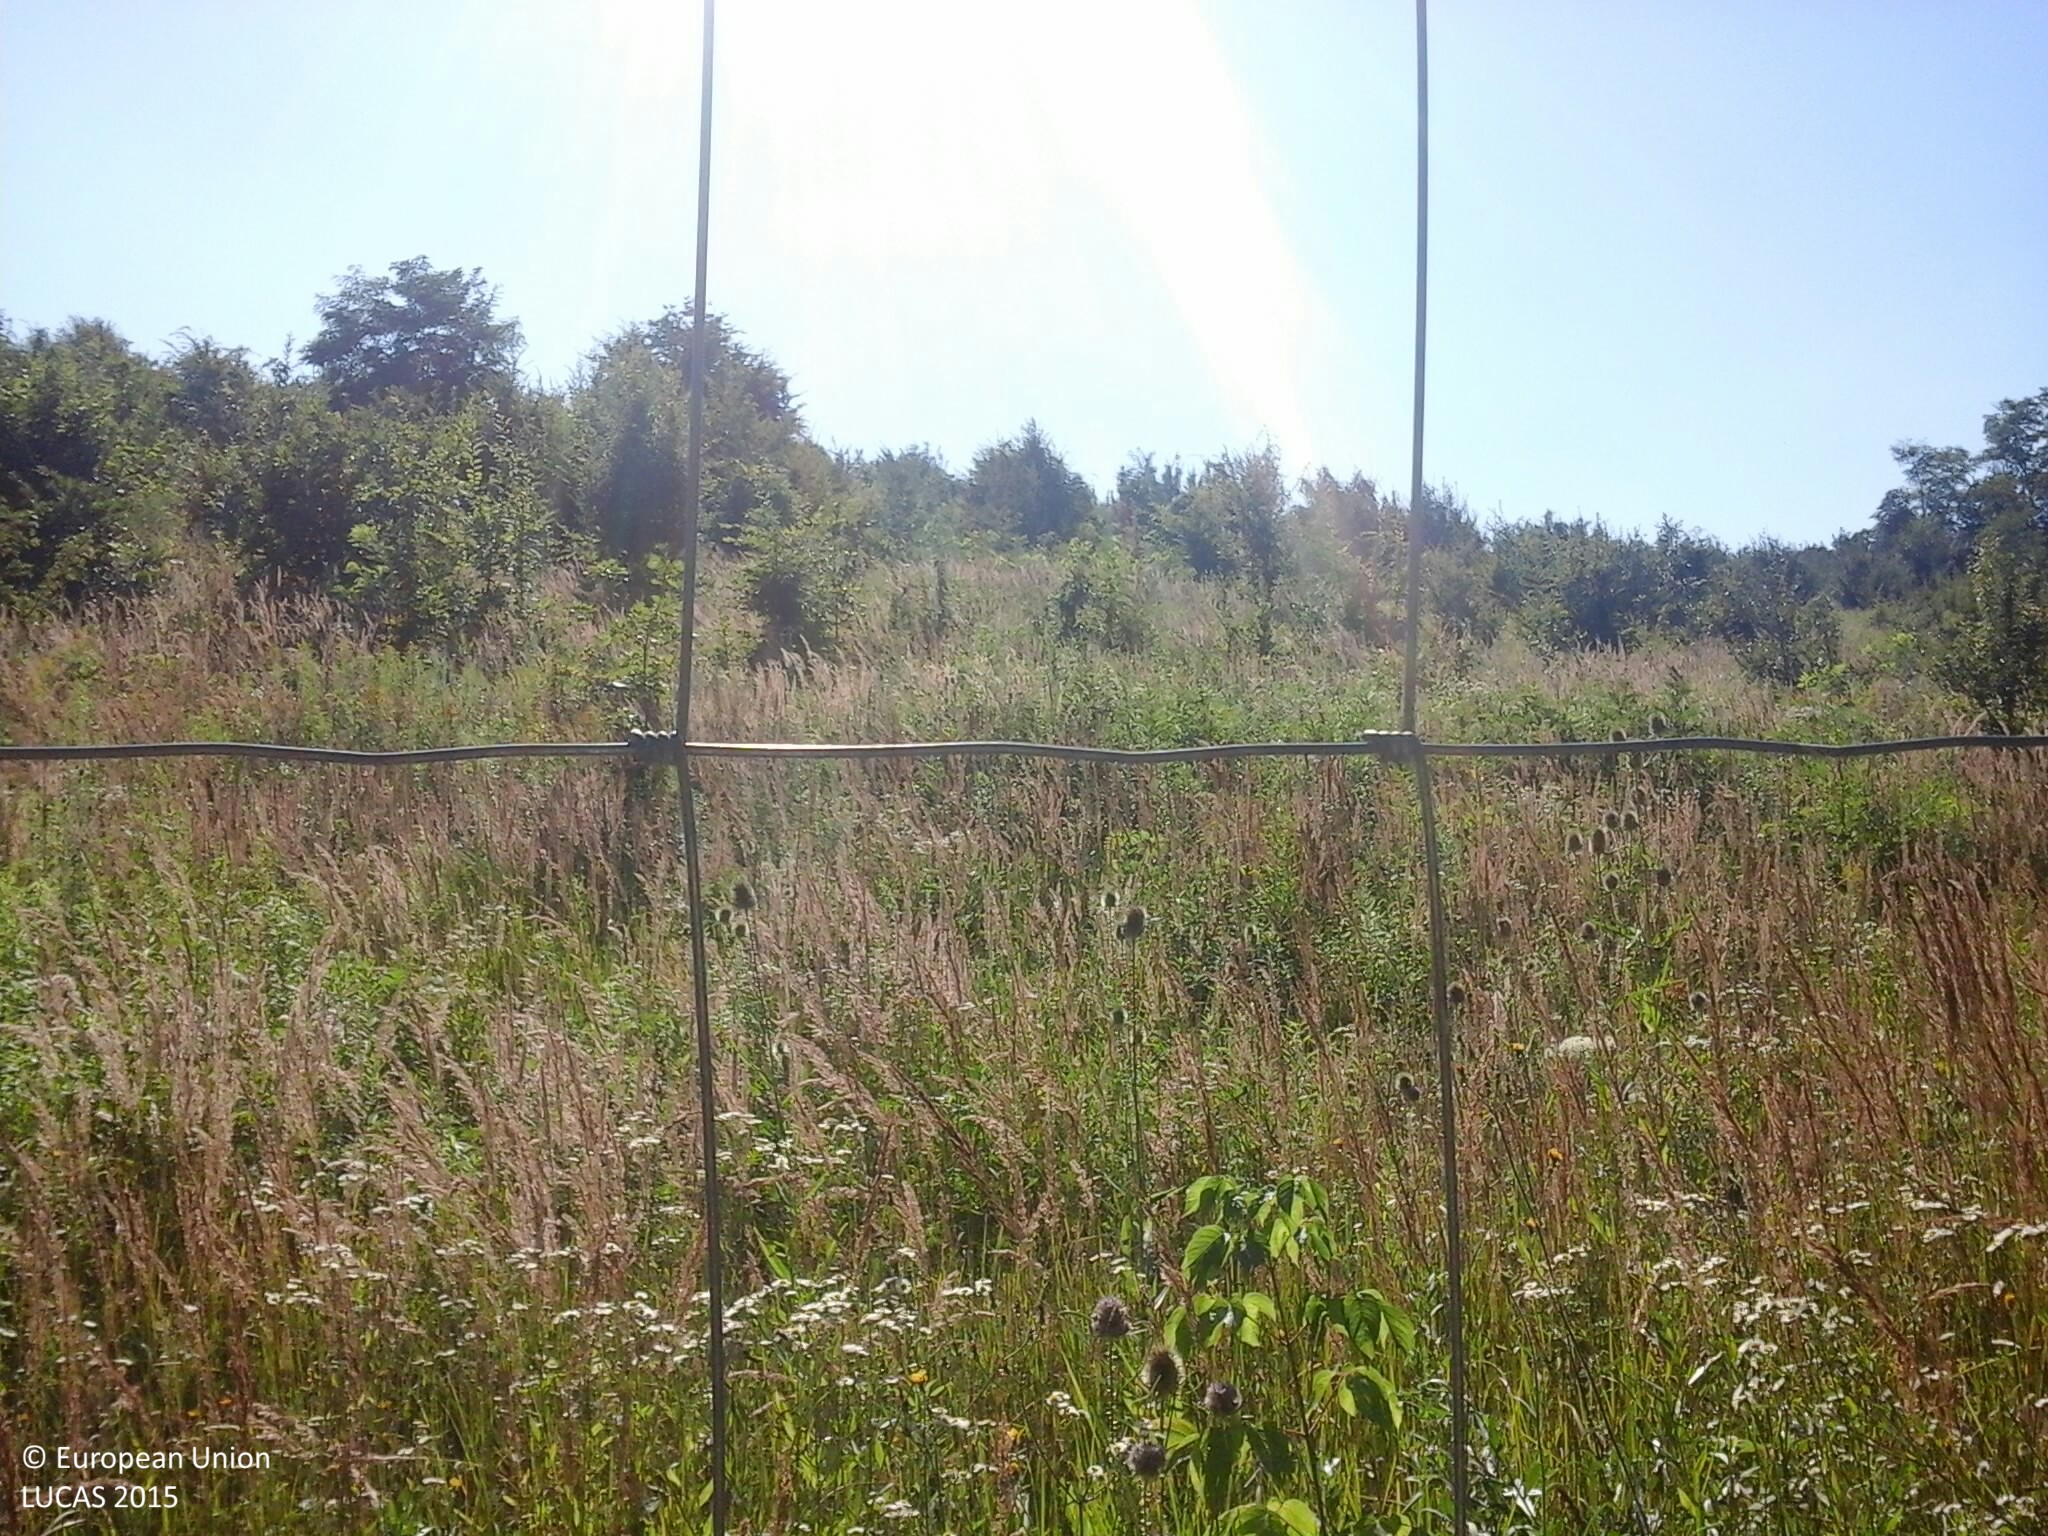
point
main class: Woodland
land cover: Broadleaved woodland
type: mesophytic deciduous forest
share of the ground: > 75 %
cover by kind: broadleaved forest trees 70 %, shrubs 20 %, herbaceous plants 10 %
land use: Forestry
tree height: < 5 m
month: July
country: HU
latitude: 46.6699
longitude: 17.7053
